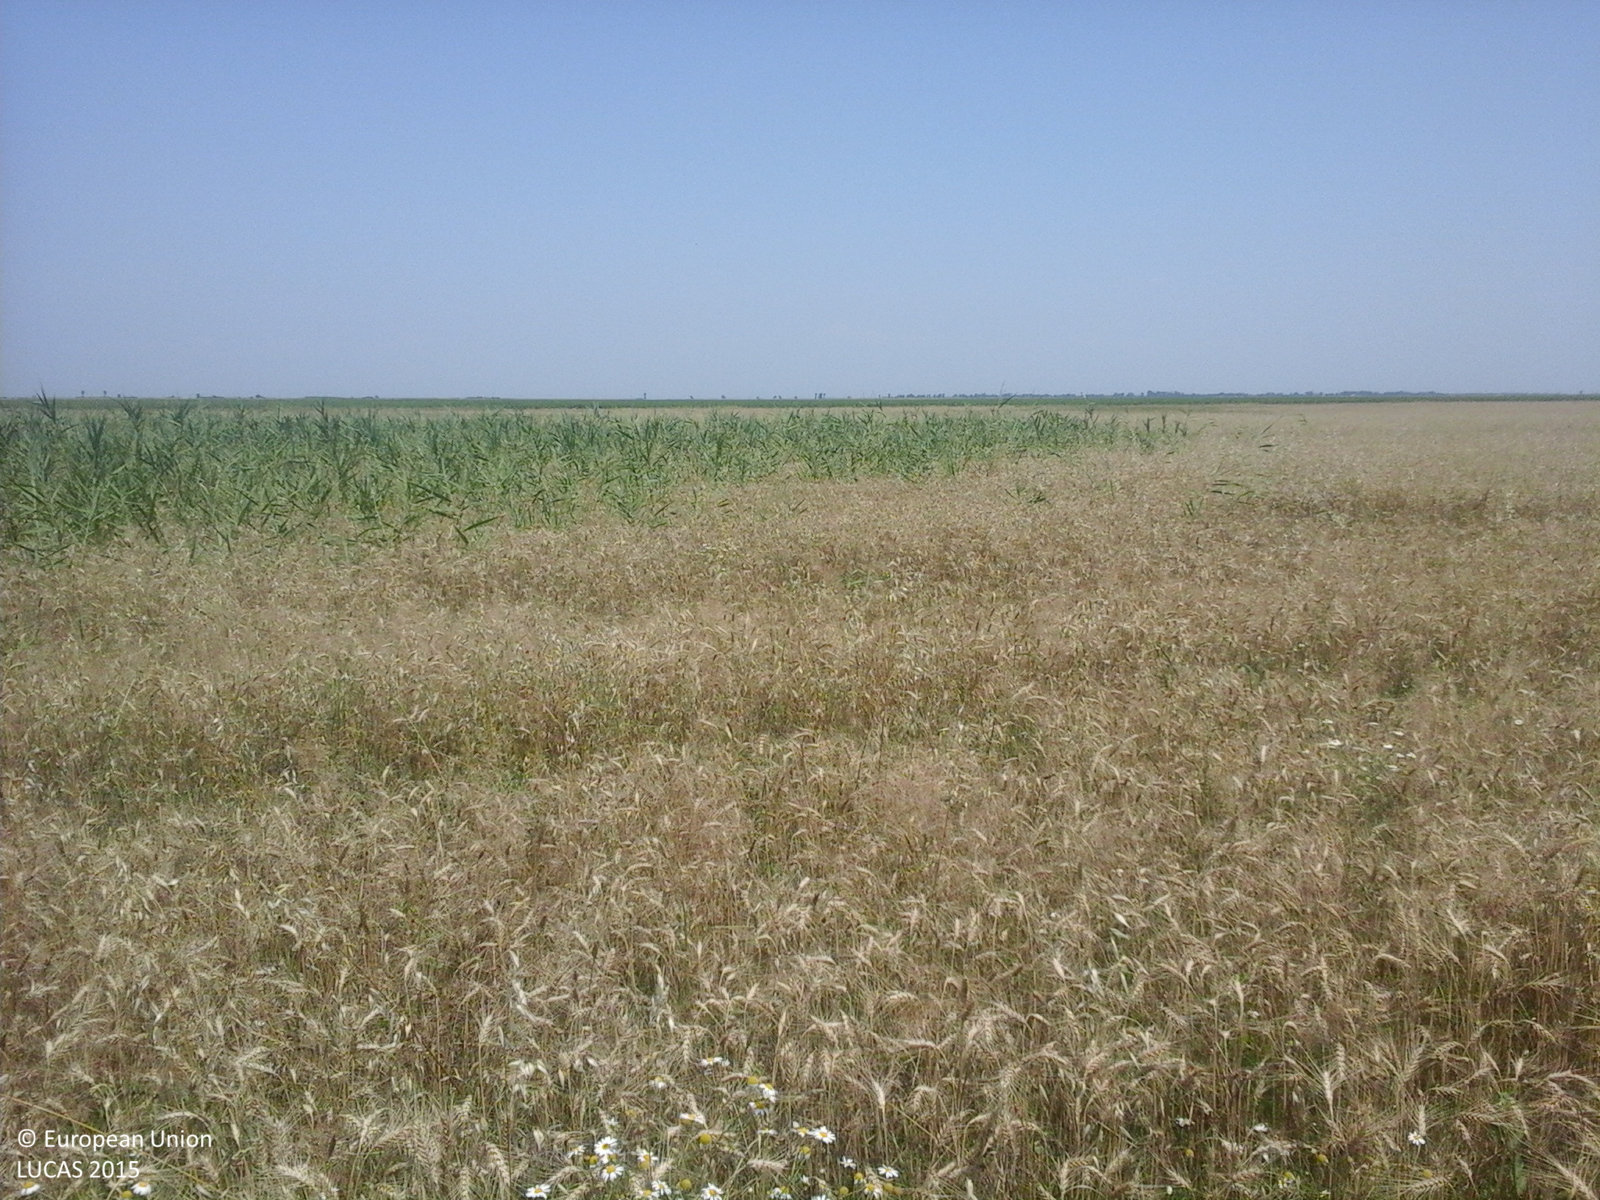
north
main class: Cropland
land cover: Mixed cereals for fodder
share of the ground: > 75 %
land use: Agriculture (excluding fallow land and kitchen gardens)
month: July
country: RO
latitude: 44.4587
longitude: 24.8963
